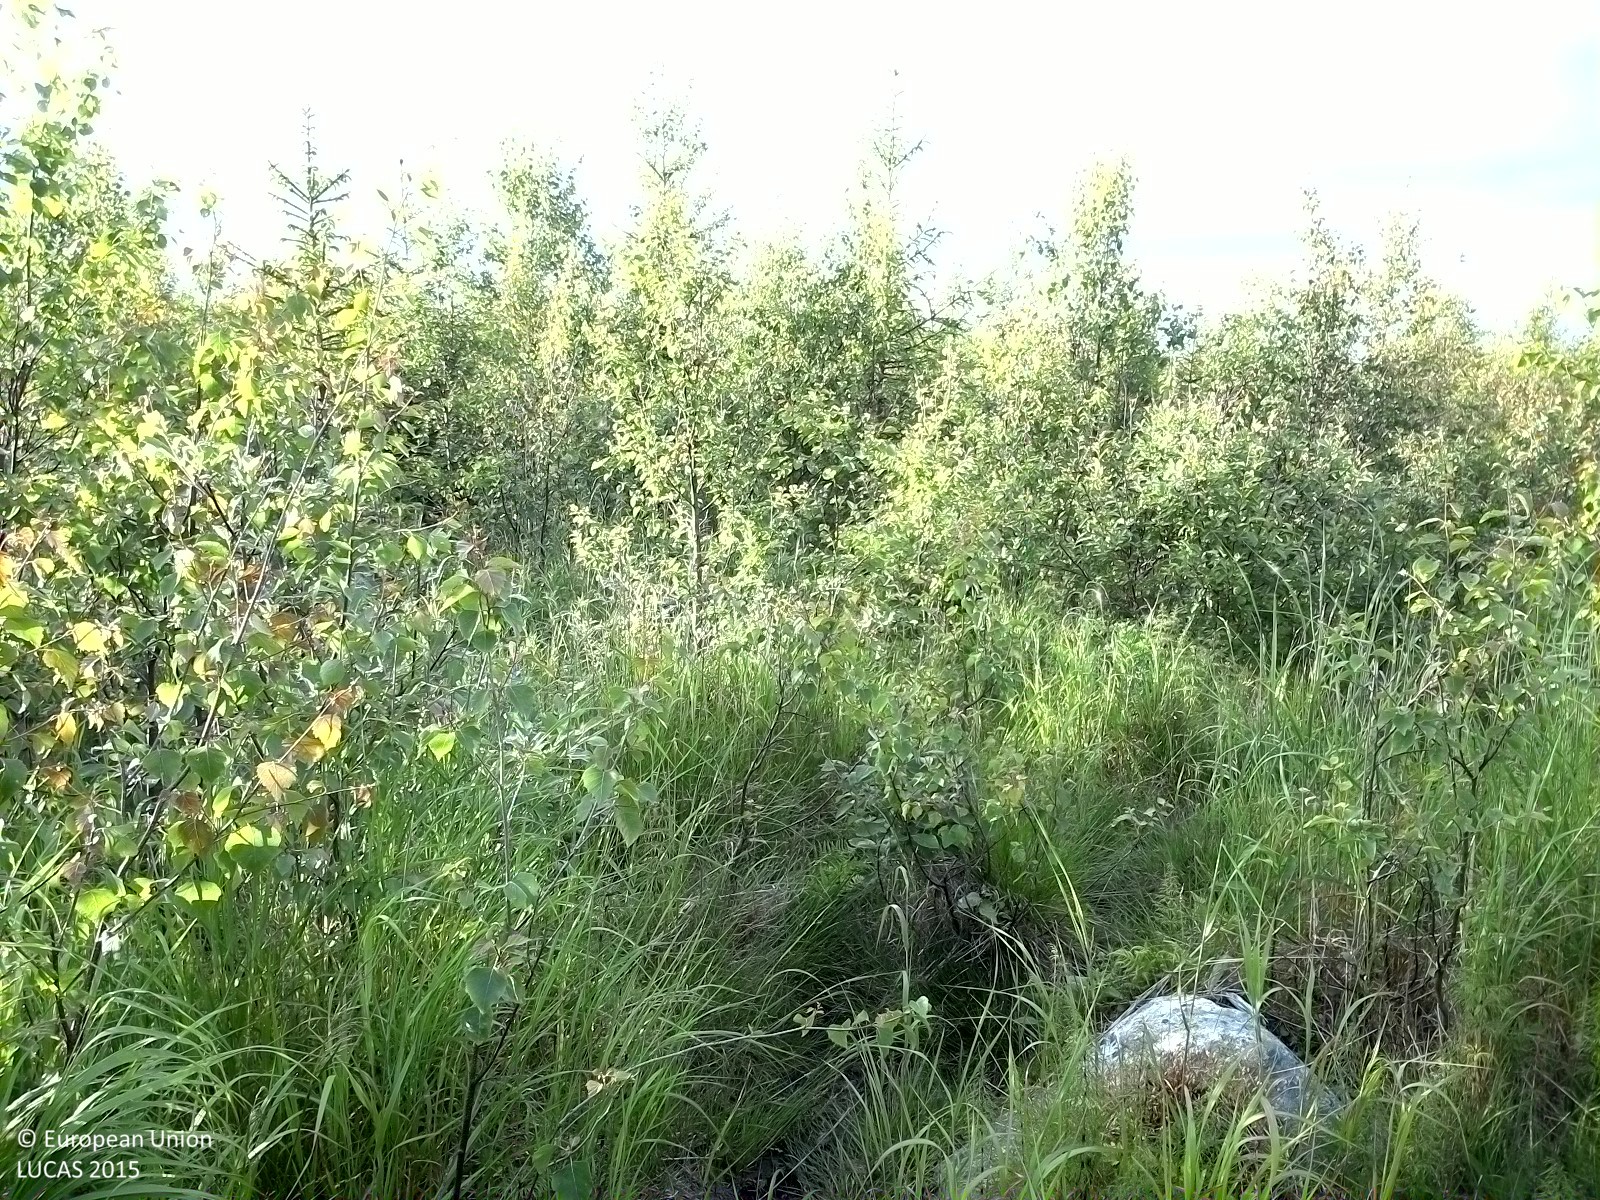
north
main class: Woodland
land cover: Broadleaved woodland
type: boreal forest
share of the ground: 50 - 75 %
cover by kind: broadleaved forest trees 55 %, herbaceous plants 35 %, coniferous forest trees 5 %, unconsolidated bare surface 5 %
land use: Forestry
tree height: < 5 m
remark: Clear cut
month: July
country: SE
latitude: 62.1836
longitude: 16.8773
